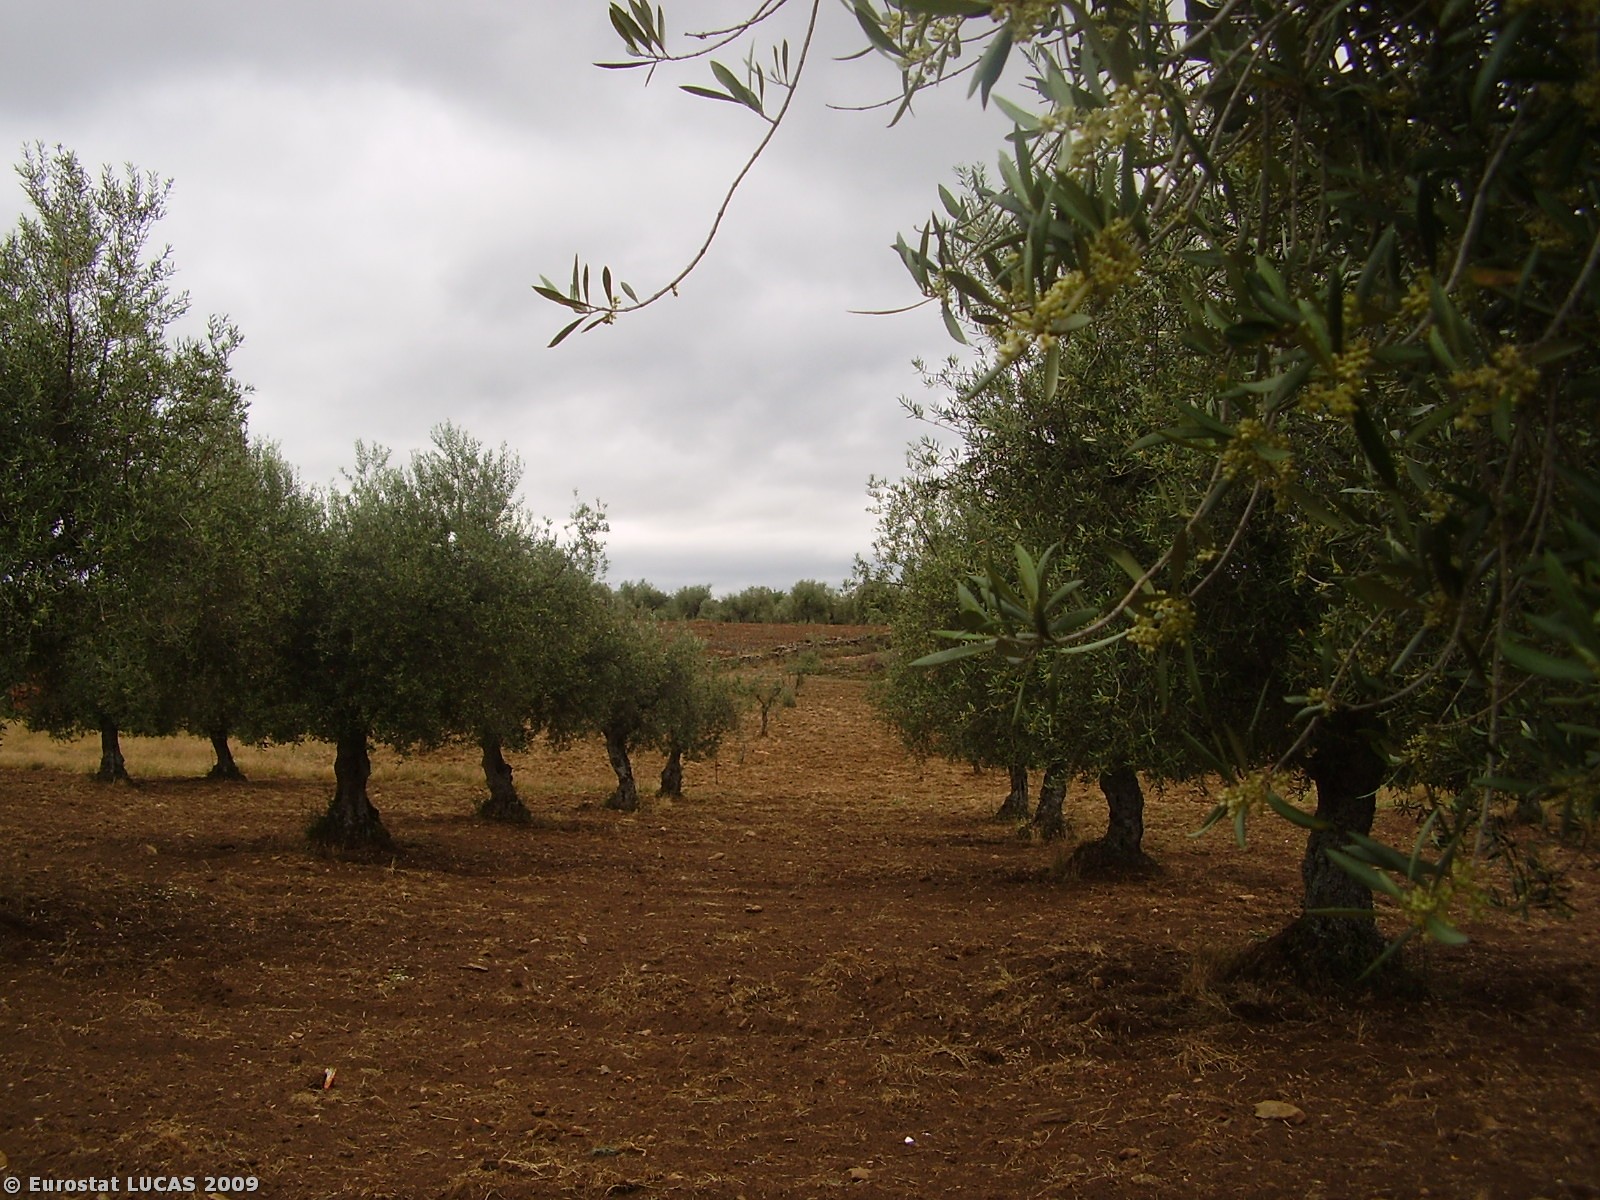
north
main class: Cropland
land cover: Olive groves
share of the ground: 10 - 25 %
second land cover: Bare land
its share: > 75 %
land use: Agriculture (excluding fallow land and kitchen gardens)
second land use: Unused
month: June
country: PT
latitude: 41.5540
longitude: -6.7875
